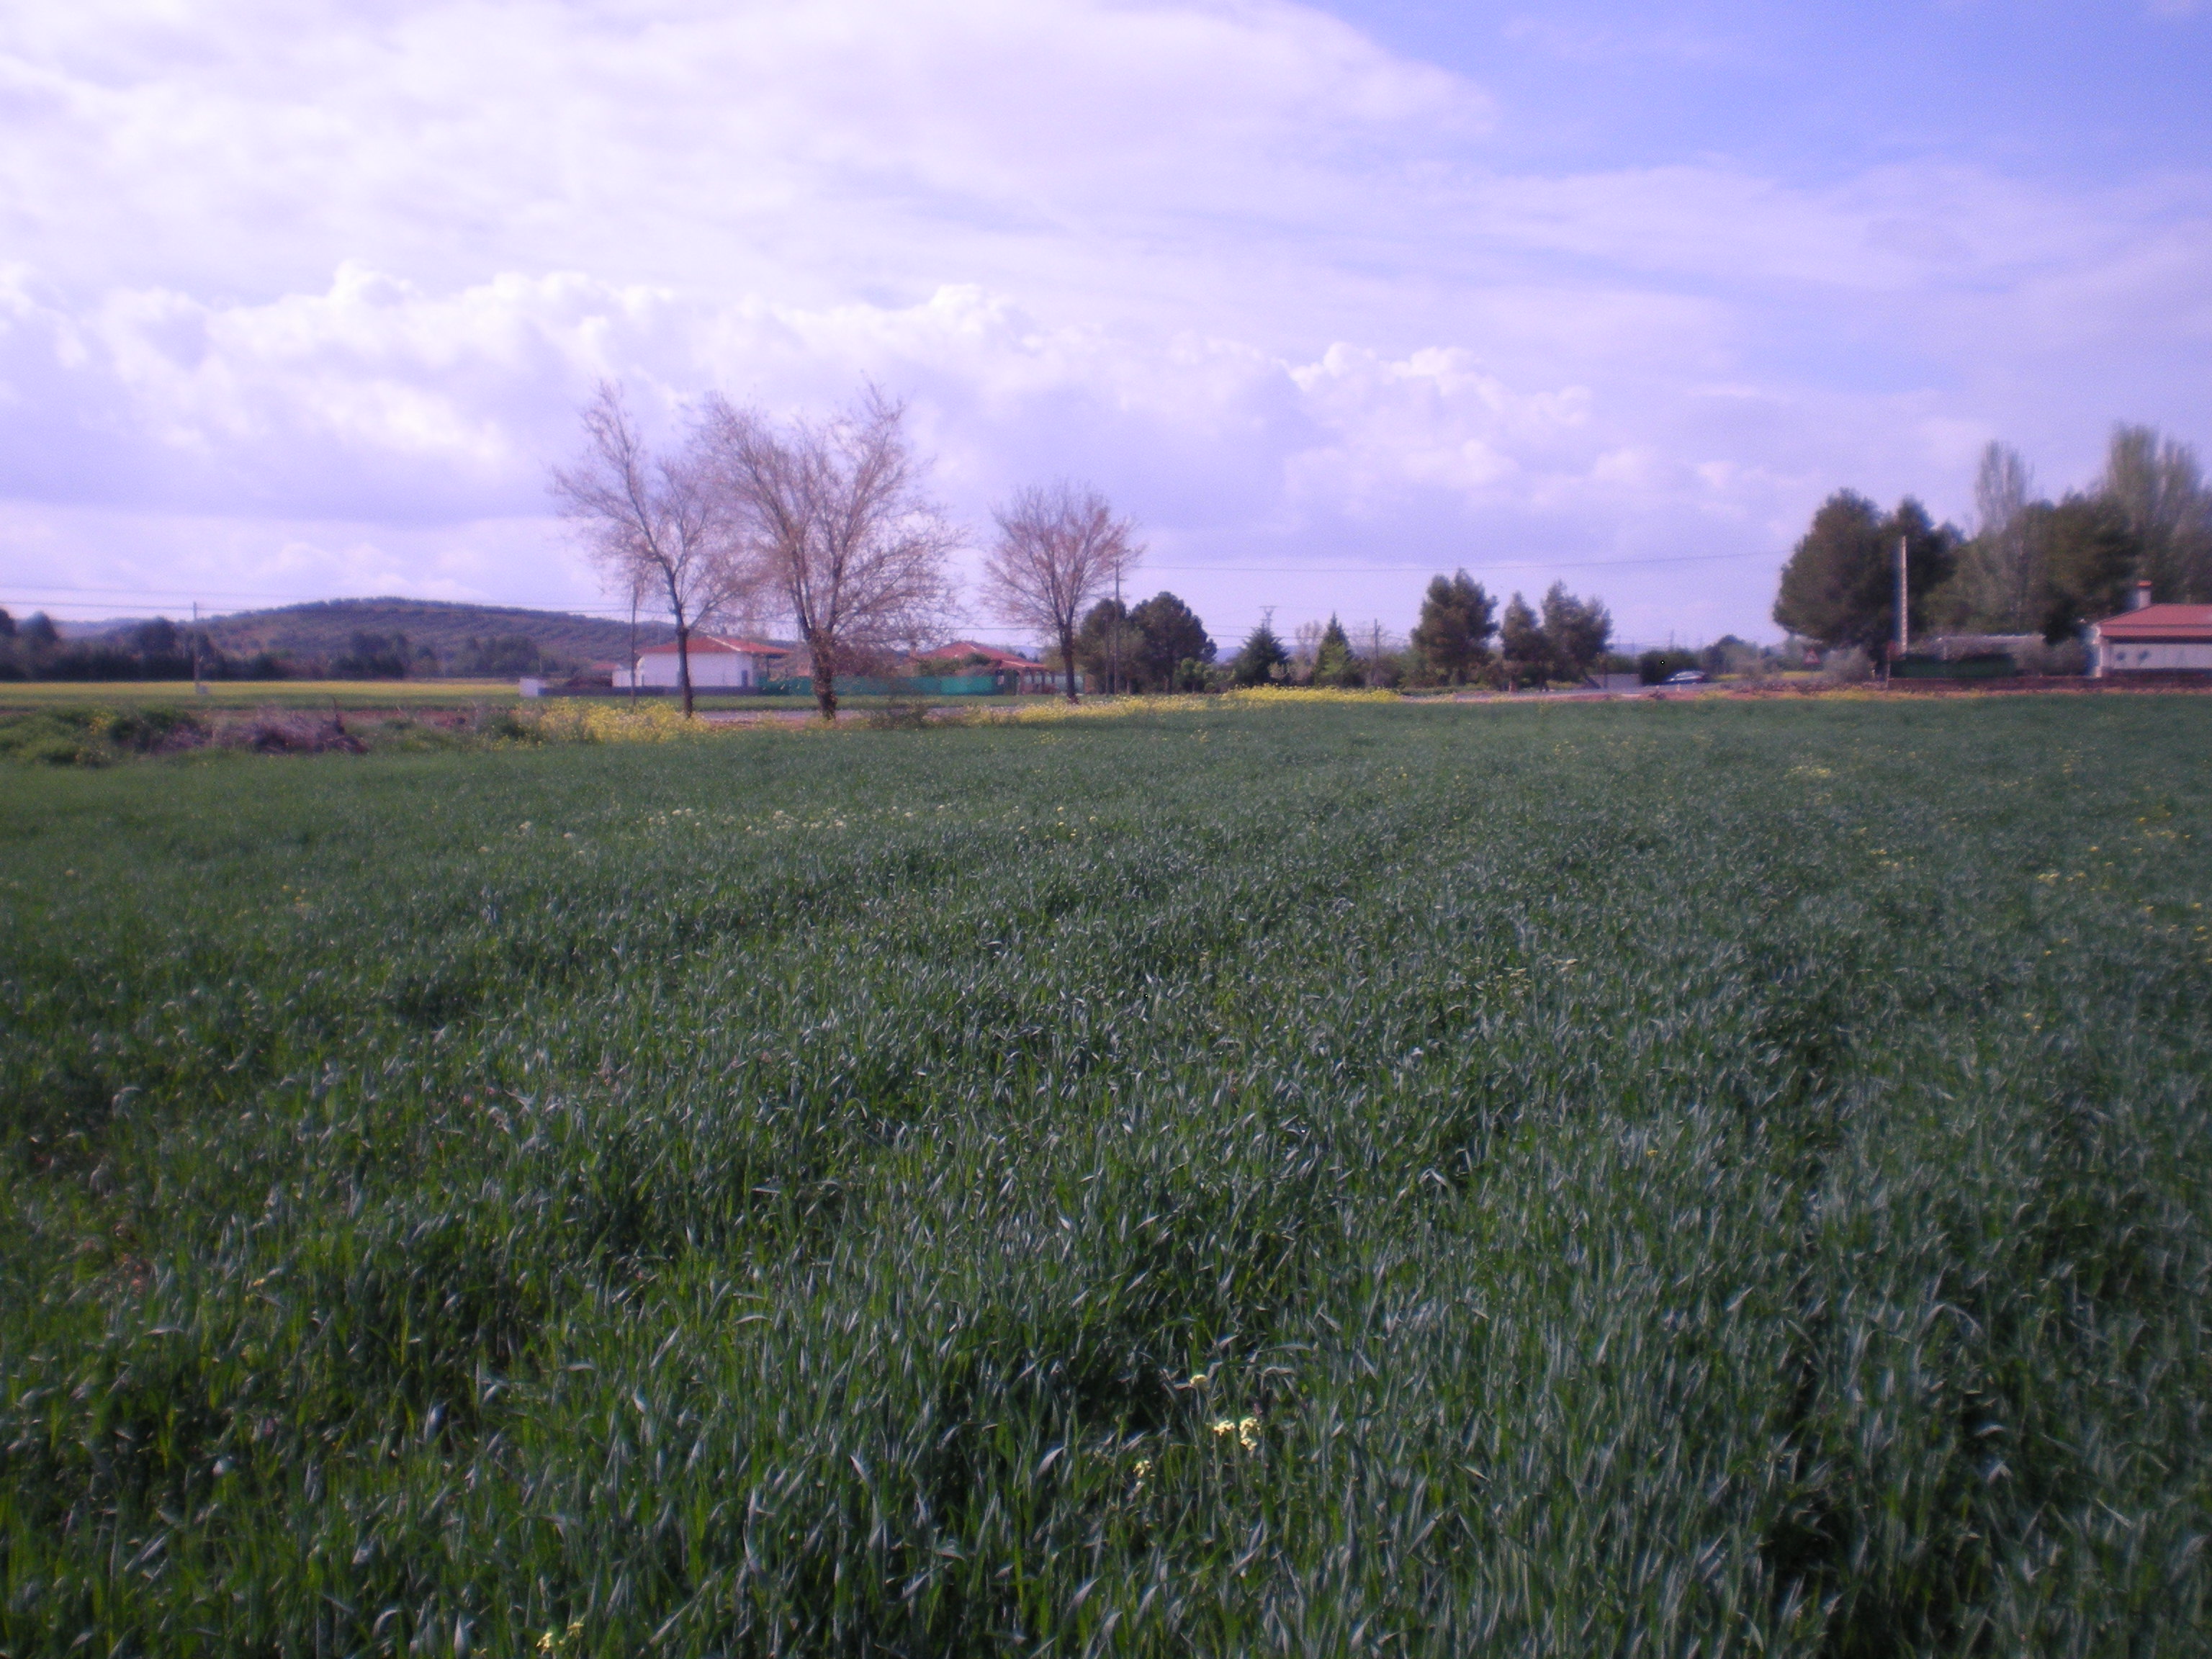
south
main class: Cropland
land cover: Durum wheat
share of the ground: > 75 %
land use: Agriculture (excluding fallow land and kitchen gardens)
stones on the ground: < 10 %
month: April
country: ES
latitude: 38.7192
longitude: -3.4097
